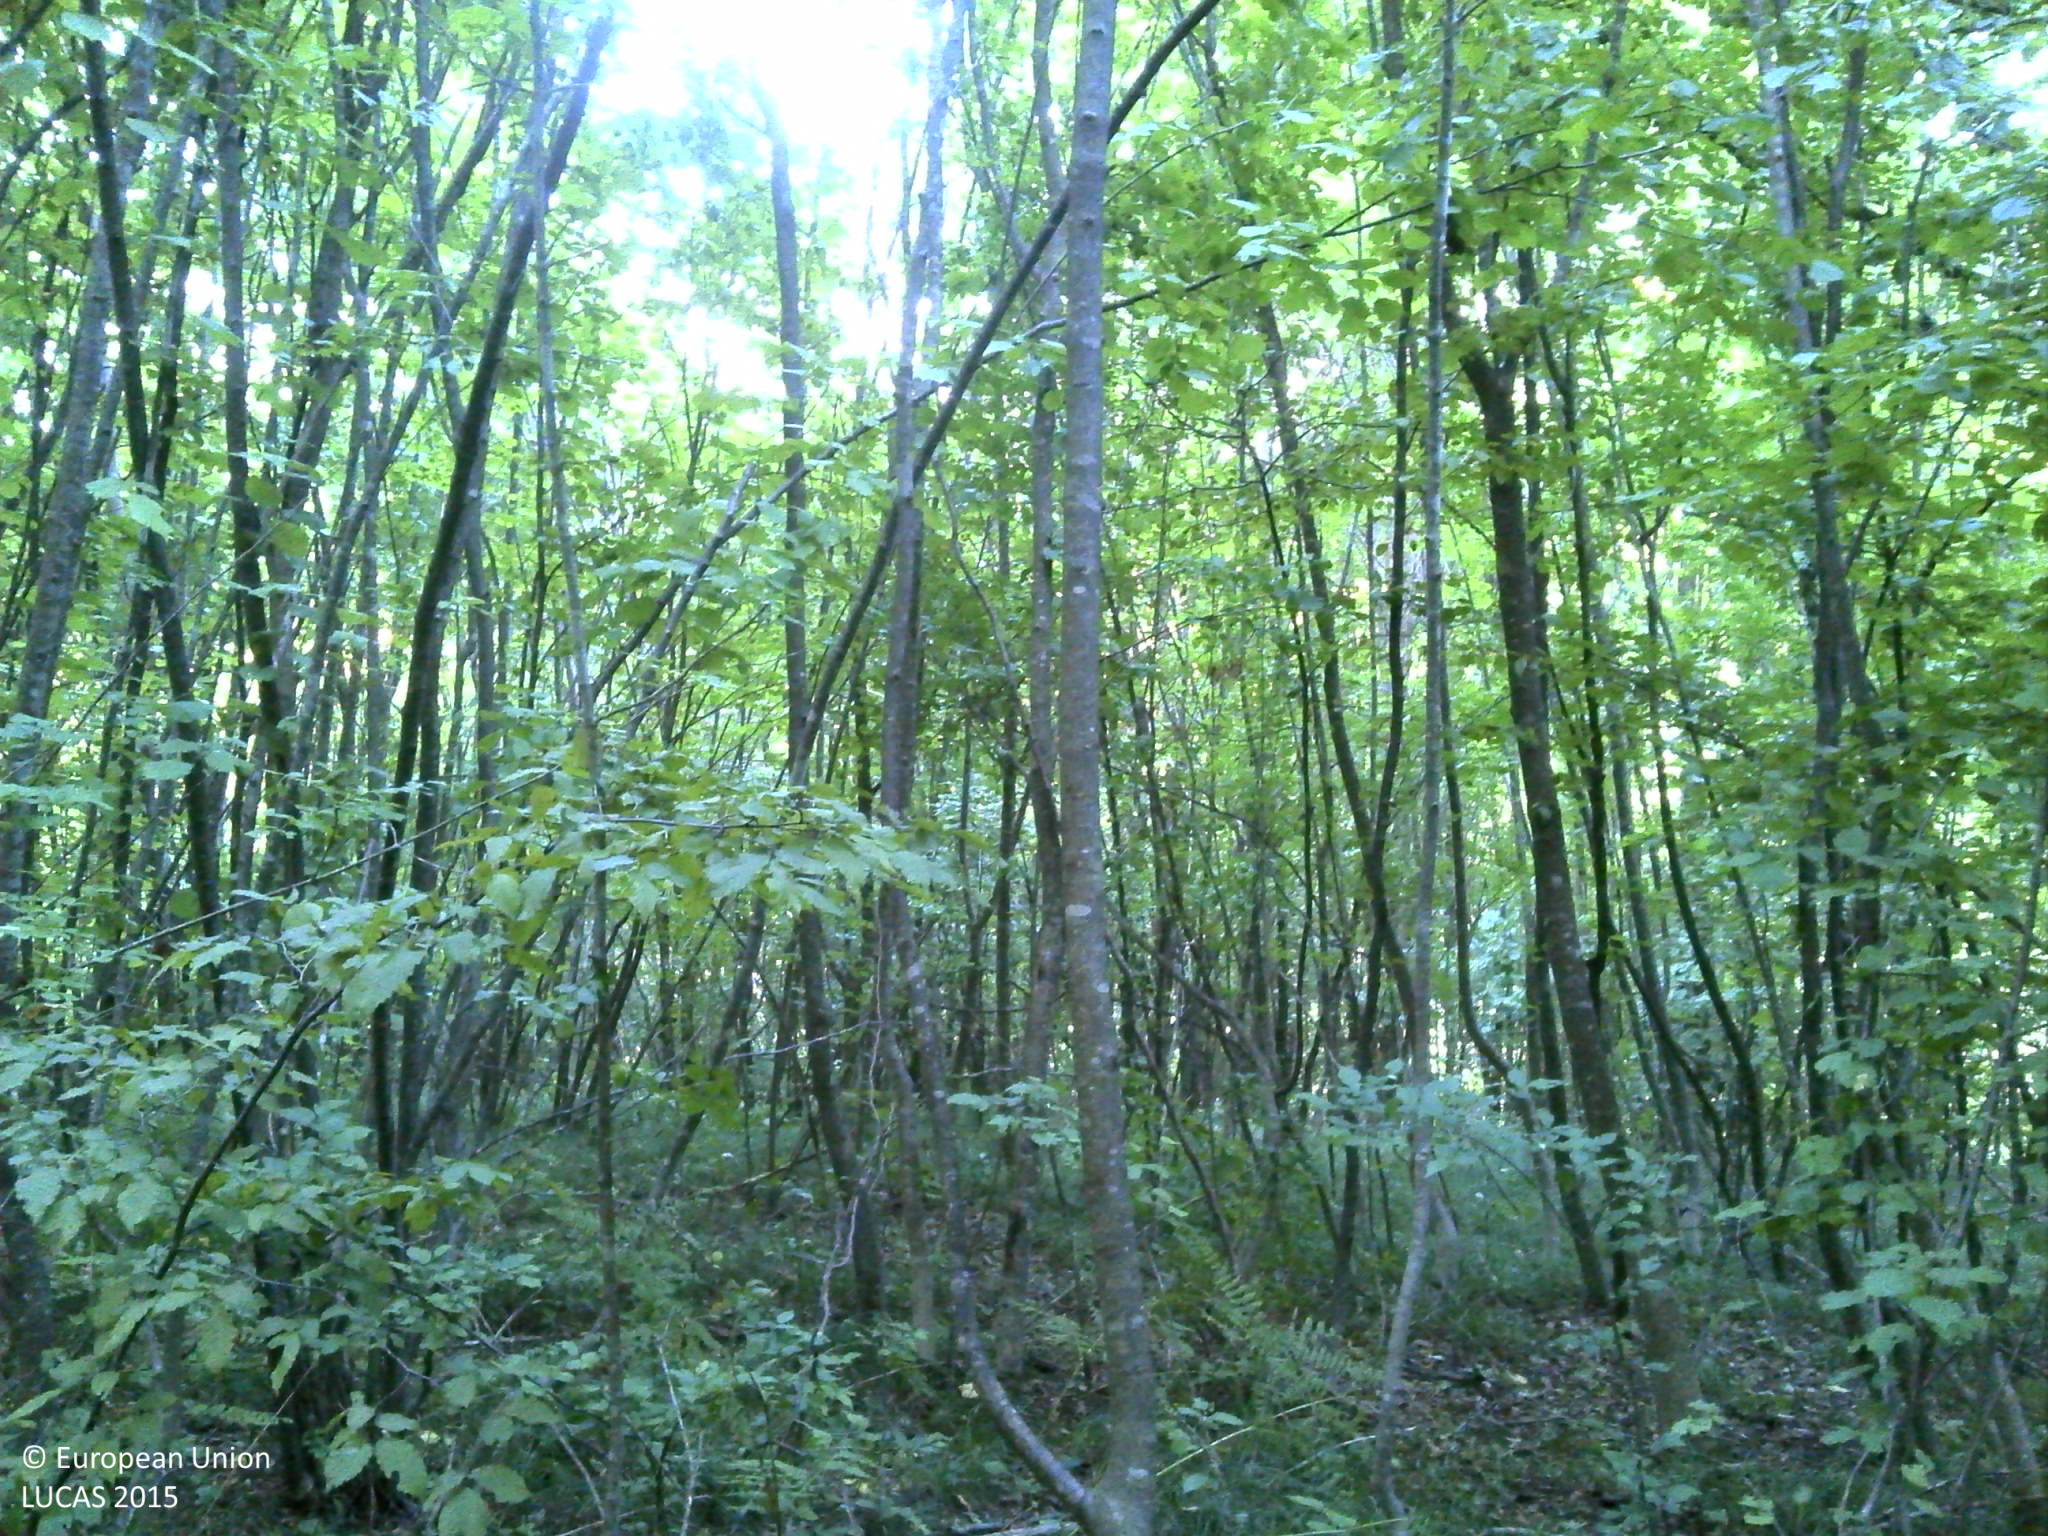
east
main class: Woodland
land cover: Broadleaved woodland
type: beech forest
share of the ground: > 75 %
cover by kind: broadleaved forest trees 100 %
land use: Forestry
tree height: > 5 m
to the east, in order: Broadleaved woodland; Grassland without tree/shrub cover; Grassland with sparse tree/shrub cover; Broadleaved woodland
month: August
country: HR
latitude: 45.2852
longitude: 16.5124
